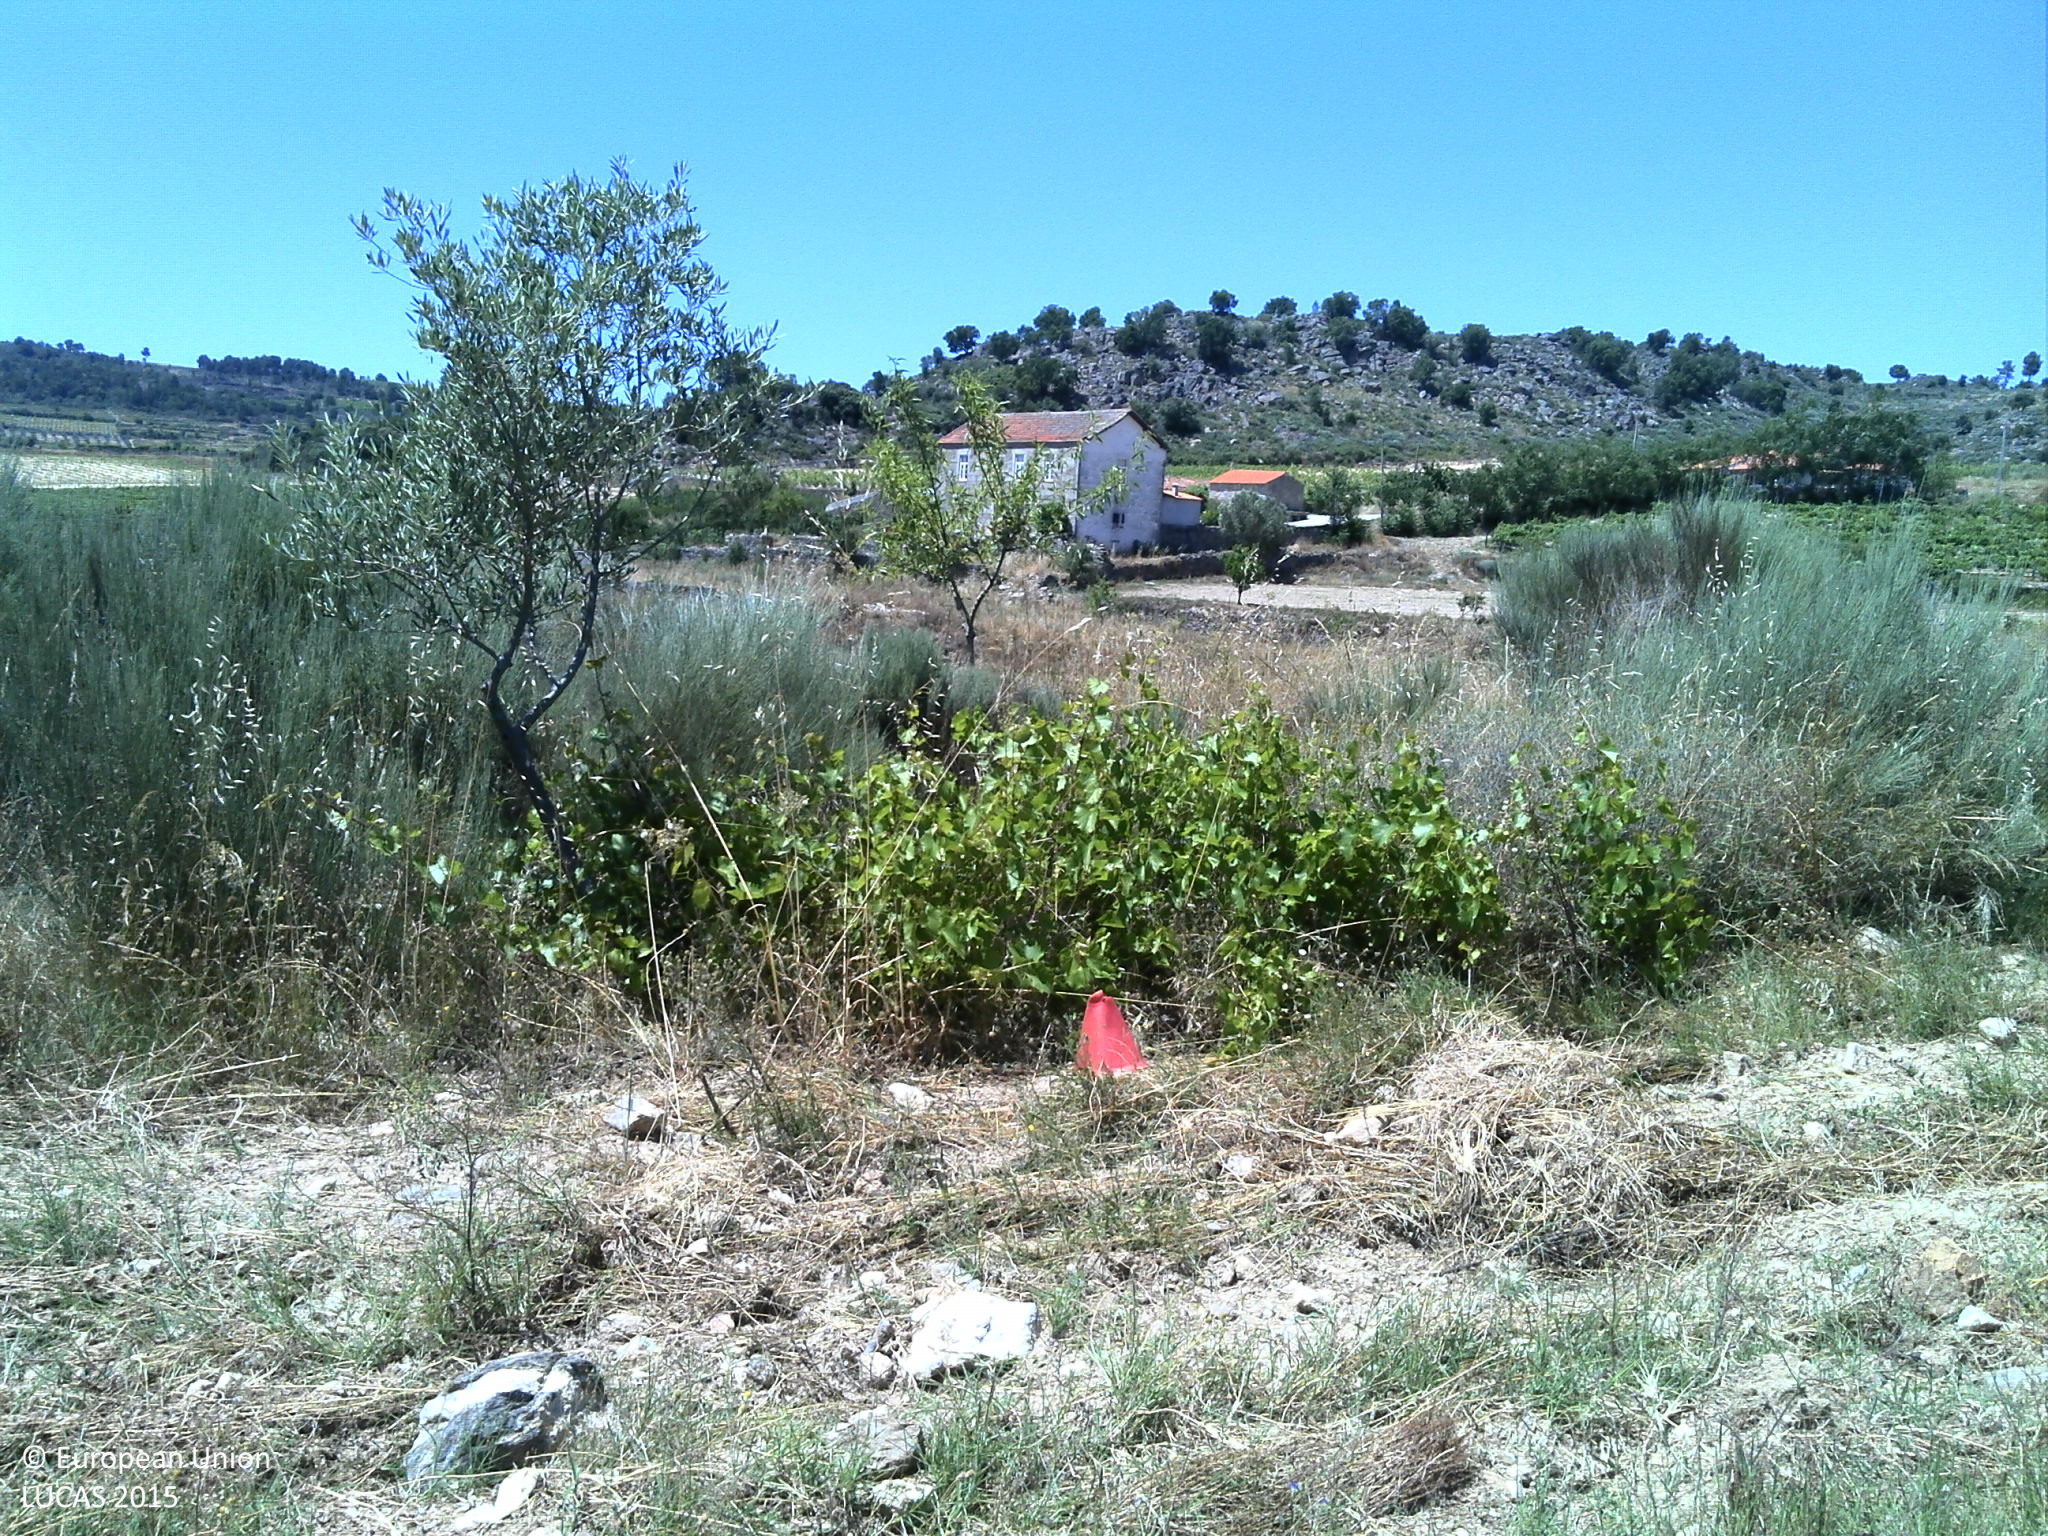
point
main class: Cropland
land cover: Olive groves
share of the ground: 10 - 25 %
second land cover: Grassland without tree/shrub cover
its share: 10 - 25 %
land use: Agriculture (excluding fallow land and kitchen gardens)
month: June
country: PT
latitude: 40.9177
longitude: -7.2697
